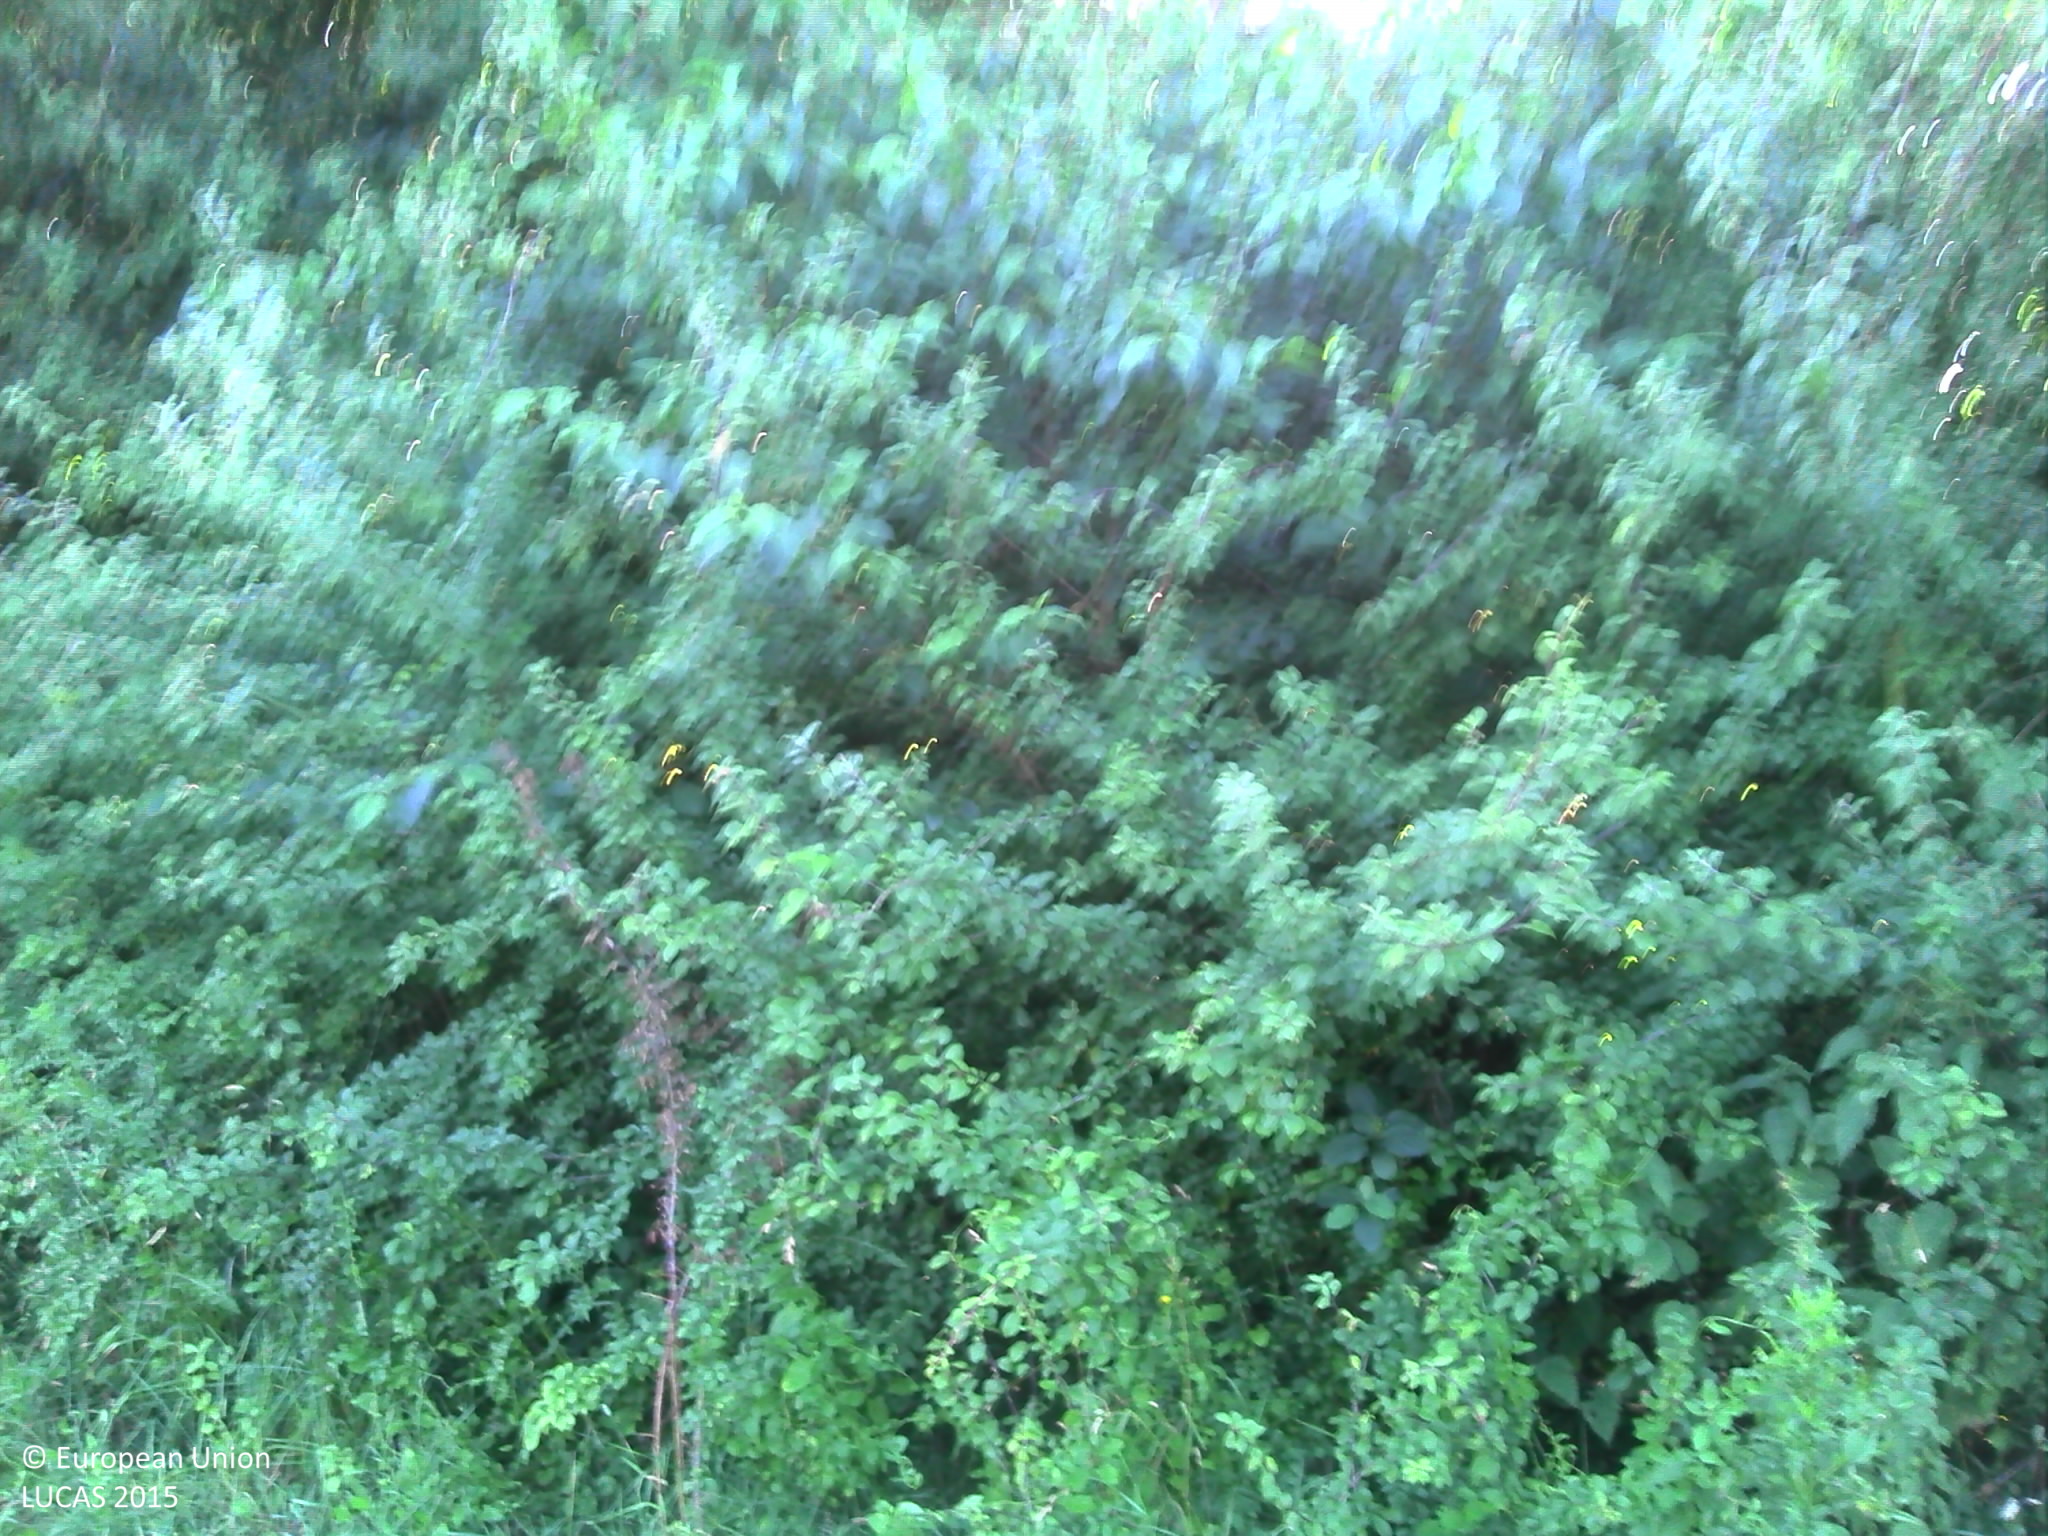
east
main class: Cropland
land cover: Apple fruit
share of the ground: 10 - 25 %
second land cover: Grassland without tree/shrub cover
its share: > 75 %
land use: Agriculture (excluding fallow land and kitchen gardens)
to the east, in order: Apple fruit; Grassland without tree/shrub cover; Broadleaved woodland; Apple fruit; Grassland with sparse tree/shrub cover; Artificial constructions in urban areas; Grassland without tree/shrub cover; Managed hedges; Fences; Grassland without tree/shrub cover
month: July
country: FR
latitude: 49.0365
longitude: -0.0027
